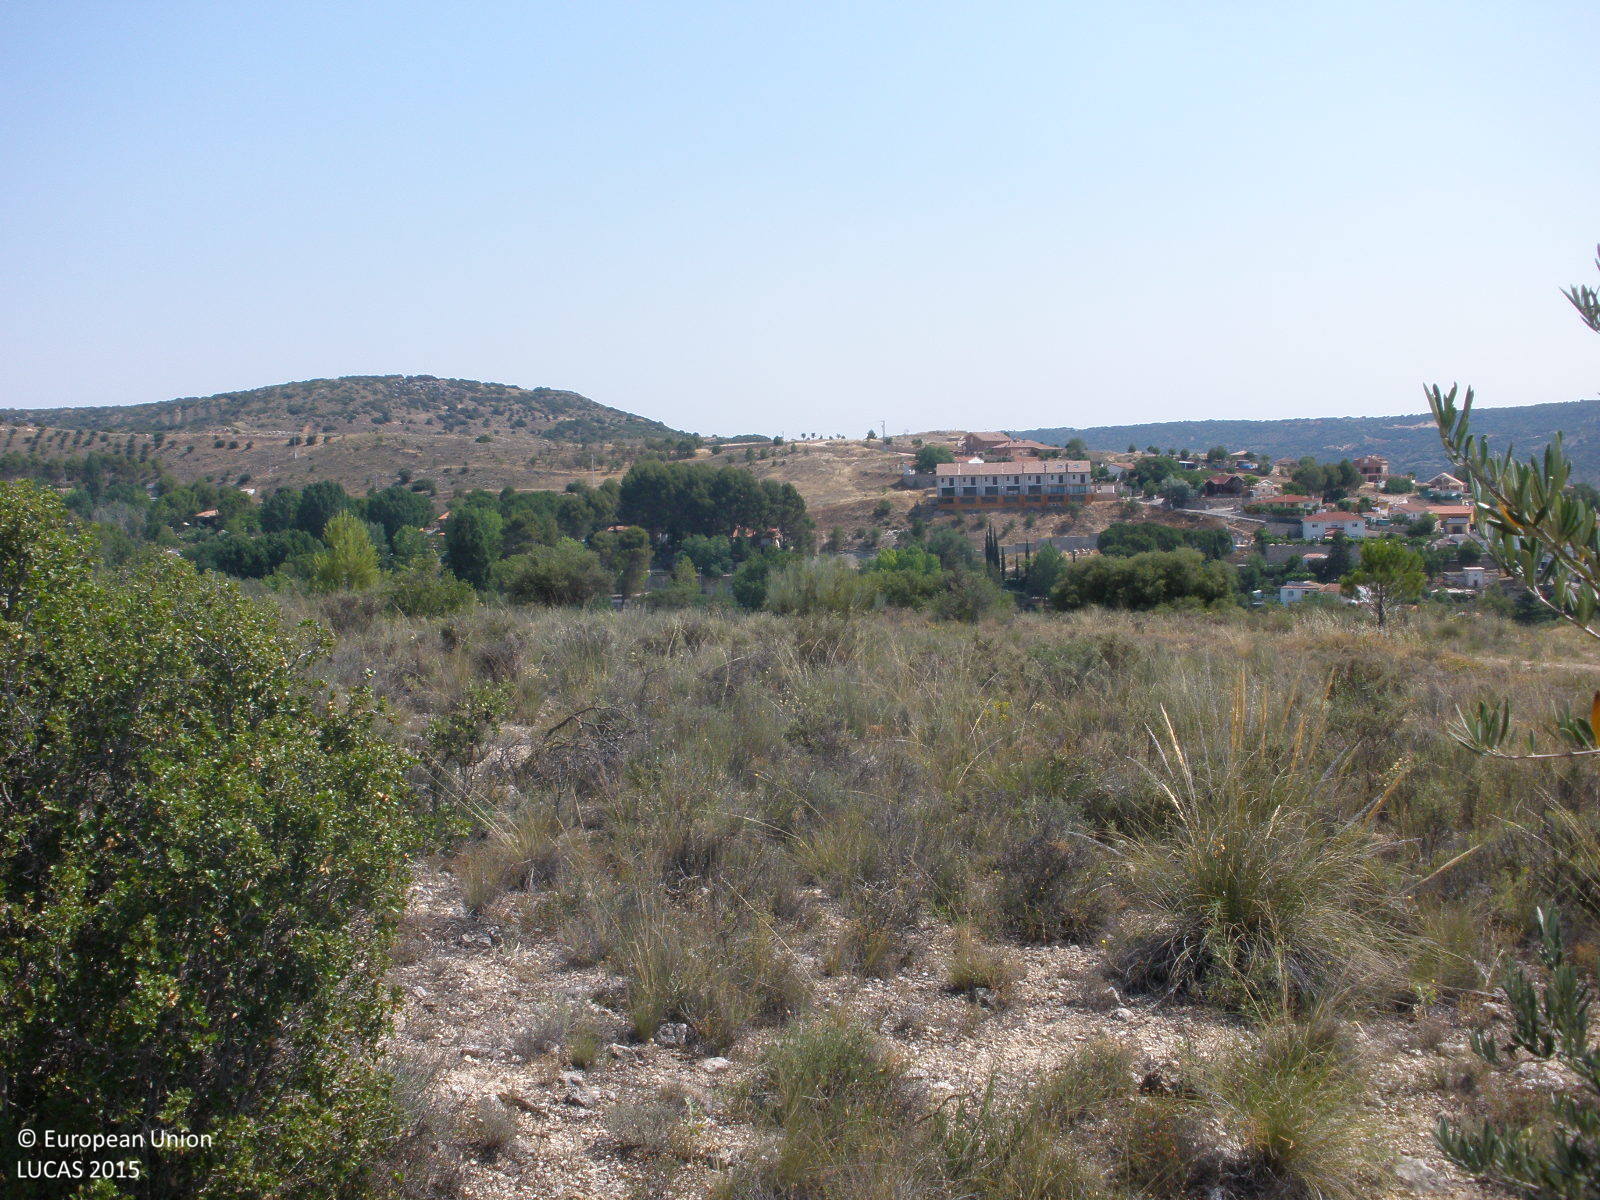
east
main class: Woodland
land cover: Broadleaved woodland
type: broadleaved evergreen forest
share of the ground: 10 - 25 %
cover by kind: shrubs 55 %, herbaceous plants 20 %, broadleaved forest trees 15 %, consolidated bare surface 10 %
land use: Semi-natural and natural areas not in use
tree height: < 5 m
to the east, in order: Broadleaved woodland; Shrubland without tree cover; Tracks; Shrubland with sparse tree cover; Tracks; Olive groves; Tracks; Shrubland with sparse tree cover; Fences; Other mixed woodland; Fences; Tracks; Broadleaved woodland; Artificial constructions in urban areas
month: June
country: ES
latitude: 40.2843
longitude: -3.2151
